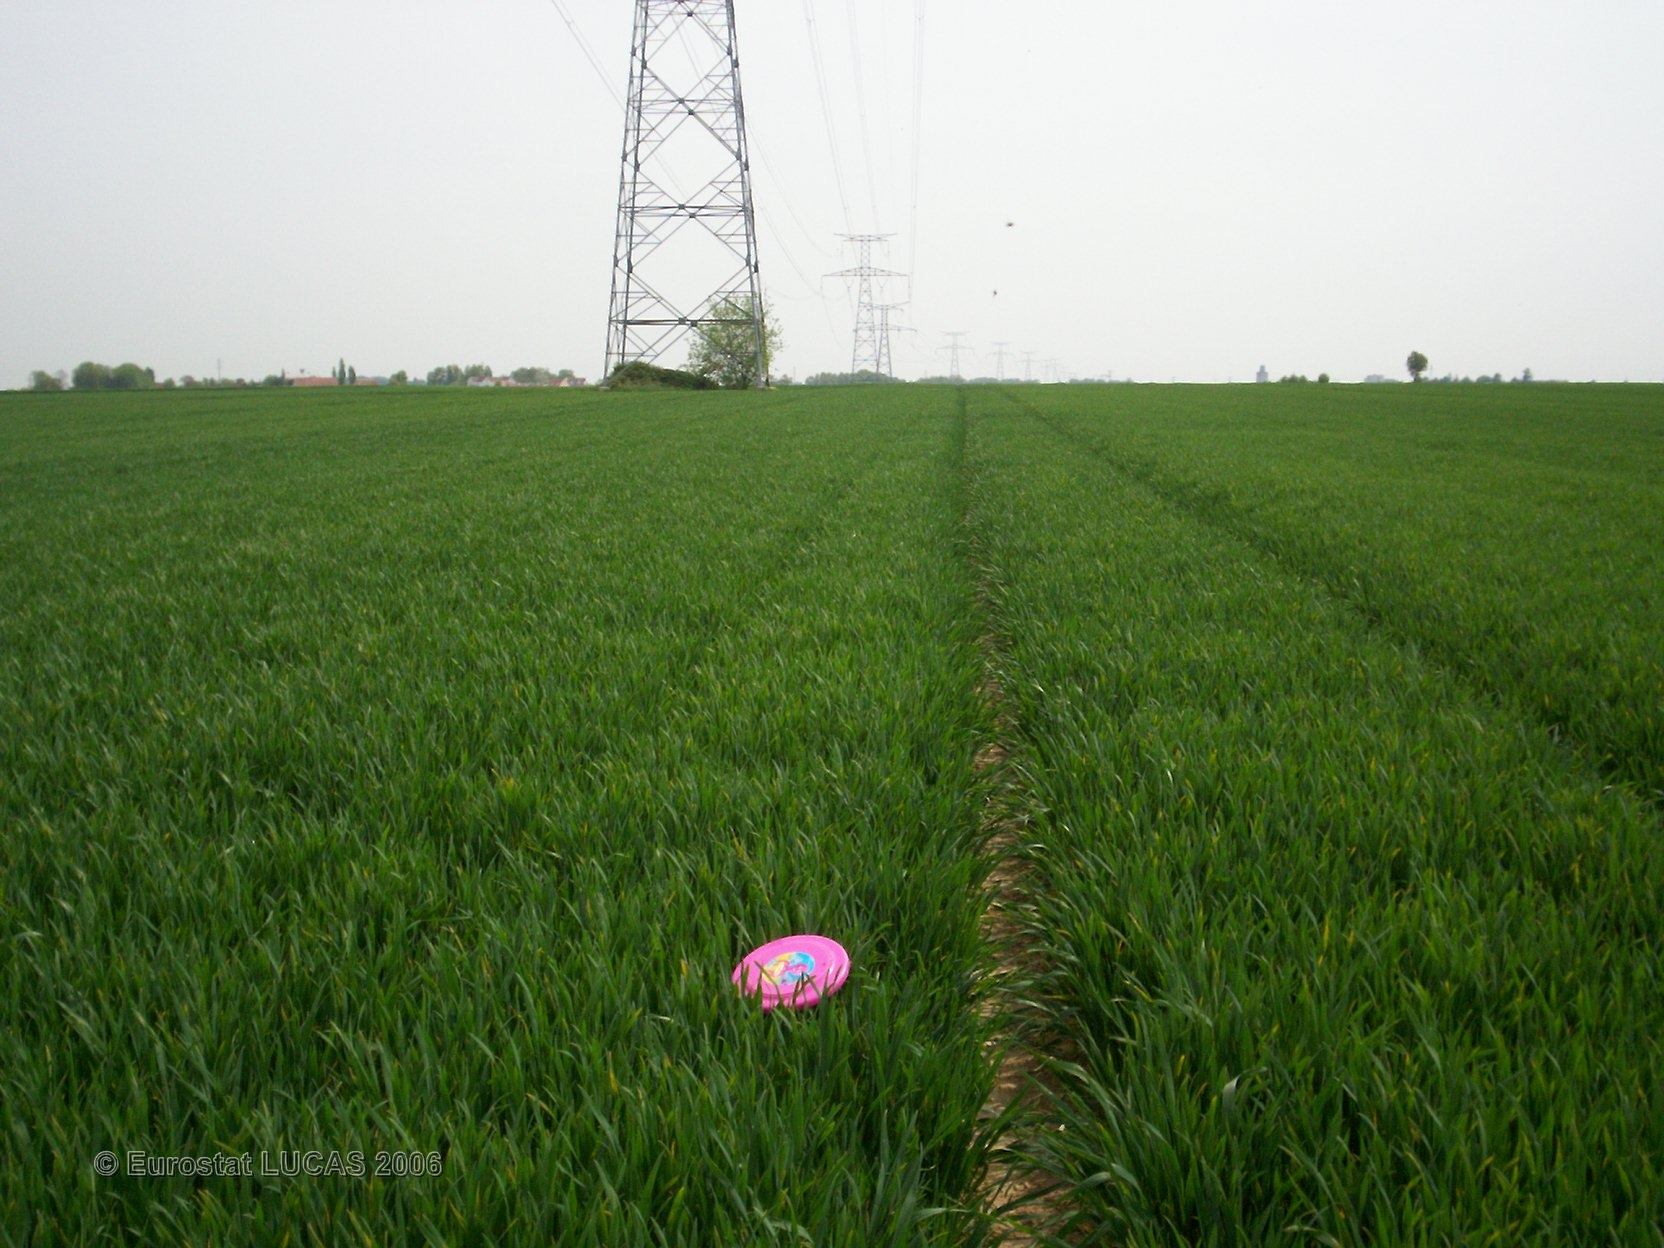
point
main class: Cropland
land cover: Common wheat
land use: Agriculture (excluding fallow land and kitchen gardens)
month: May
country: FR
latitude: 48.6229
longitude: 2.8413
